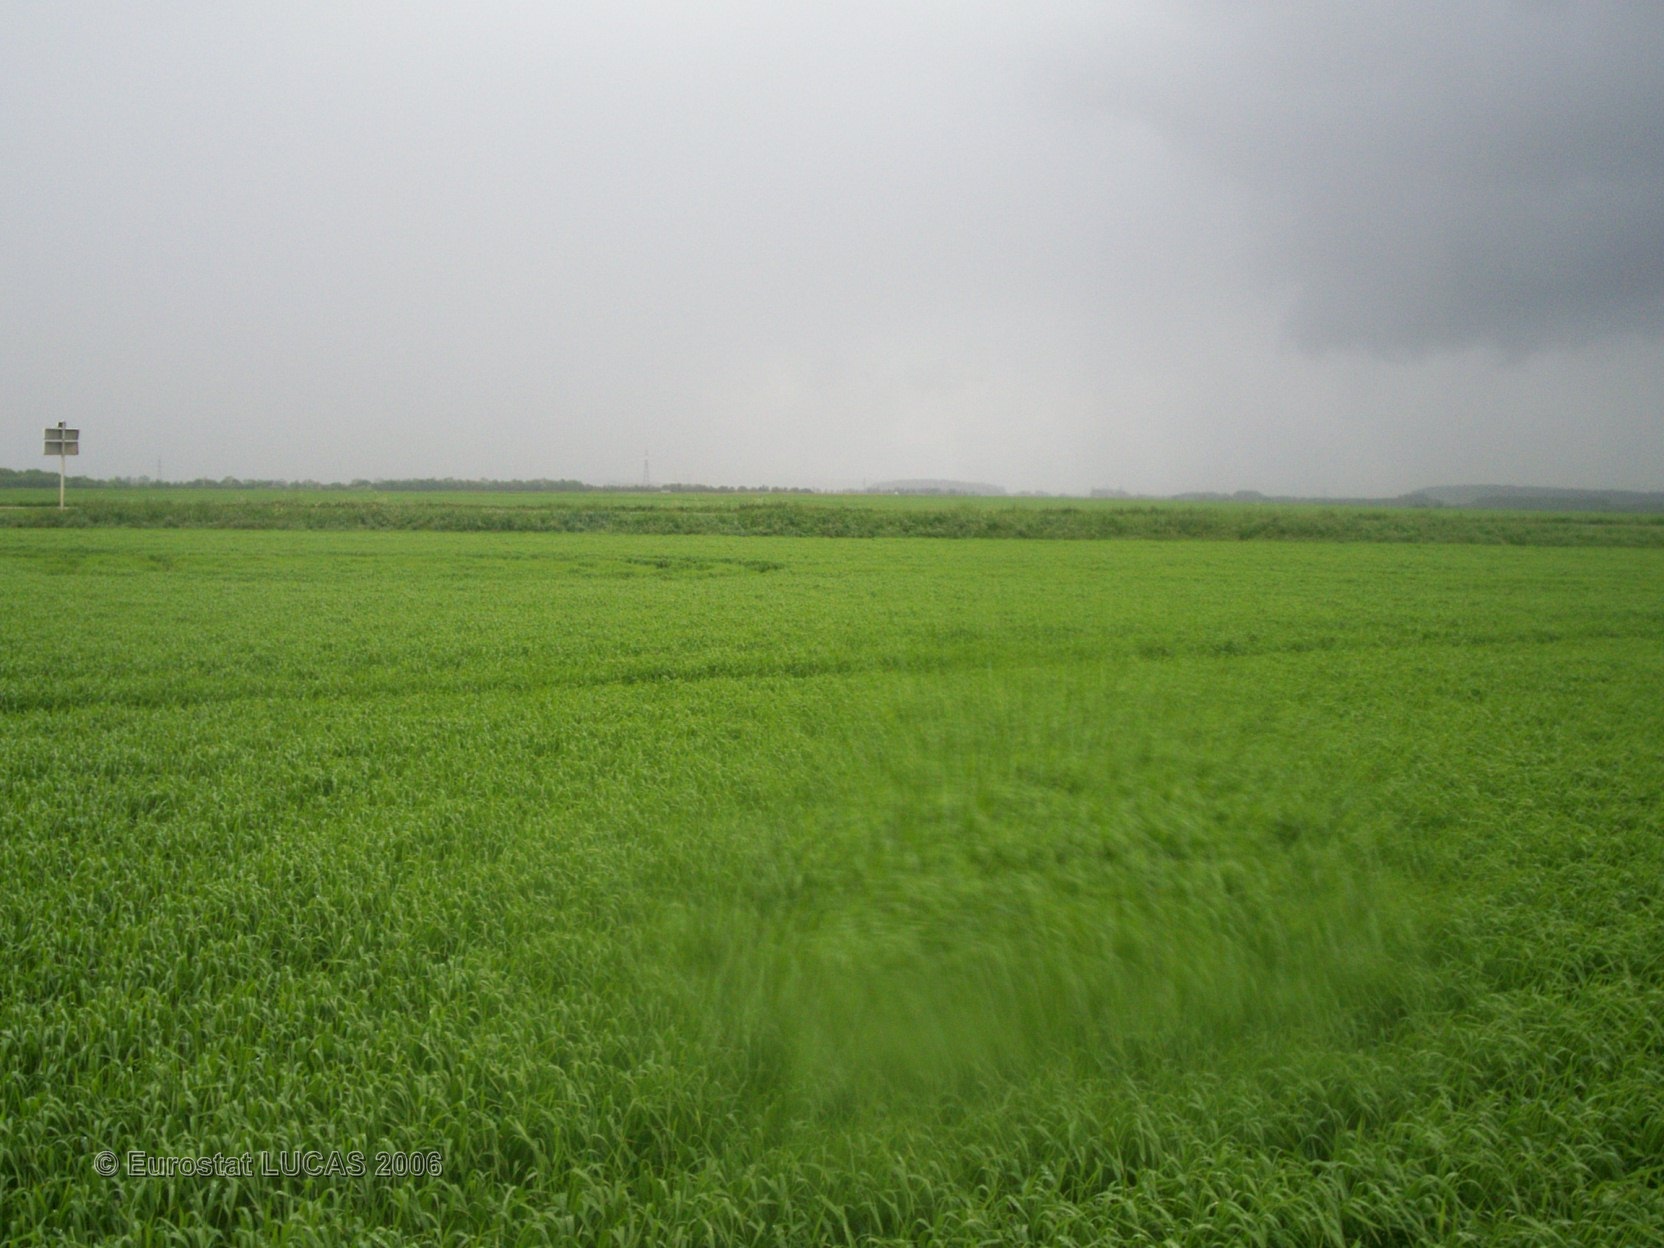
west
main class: Cropland
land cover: Barley
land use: Agriculture (excluding fallow land and kitchen gardens)
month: May
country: FR
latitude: 49.6114
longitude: 3.6687
